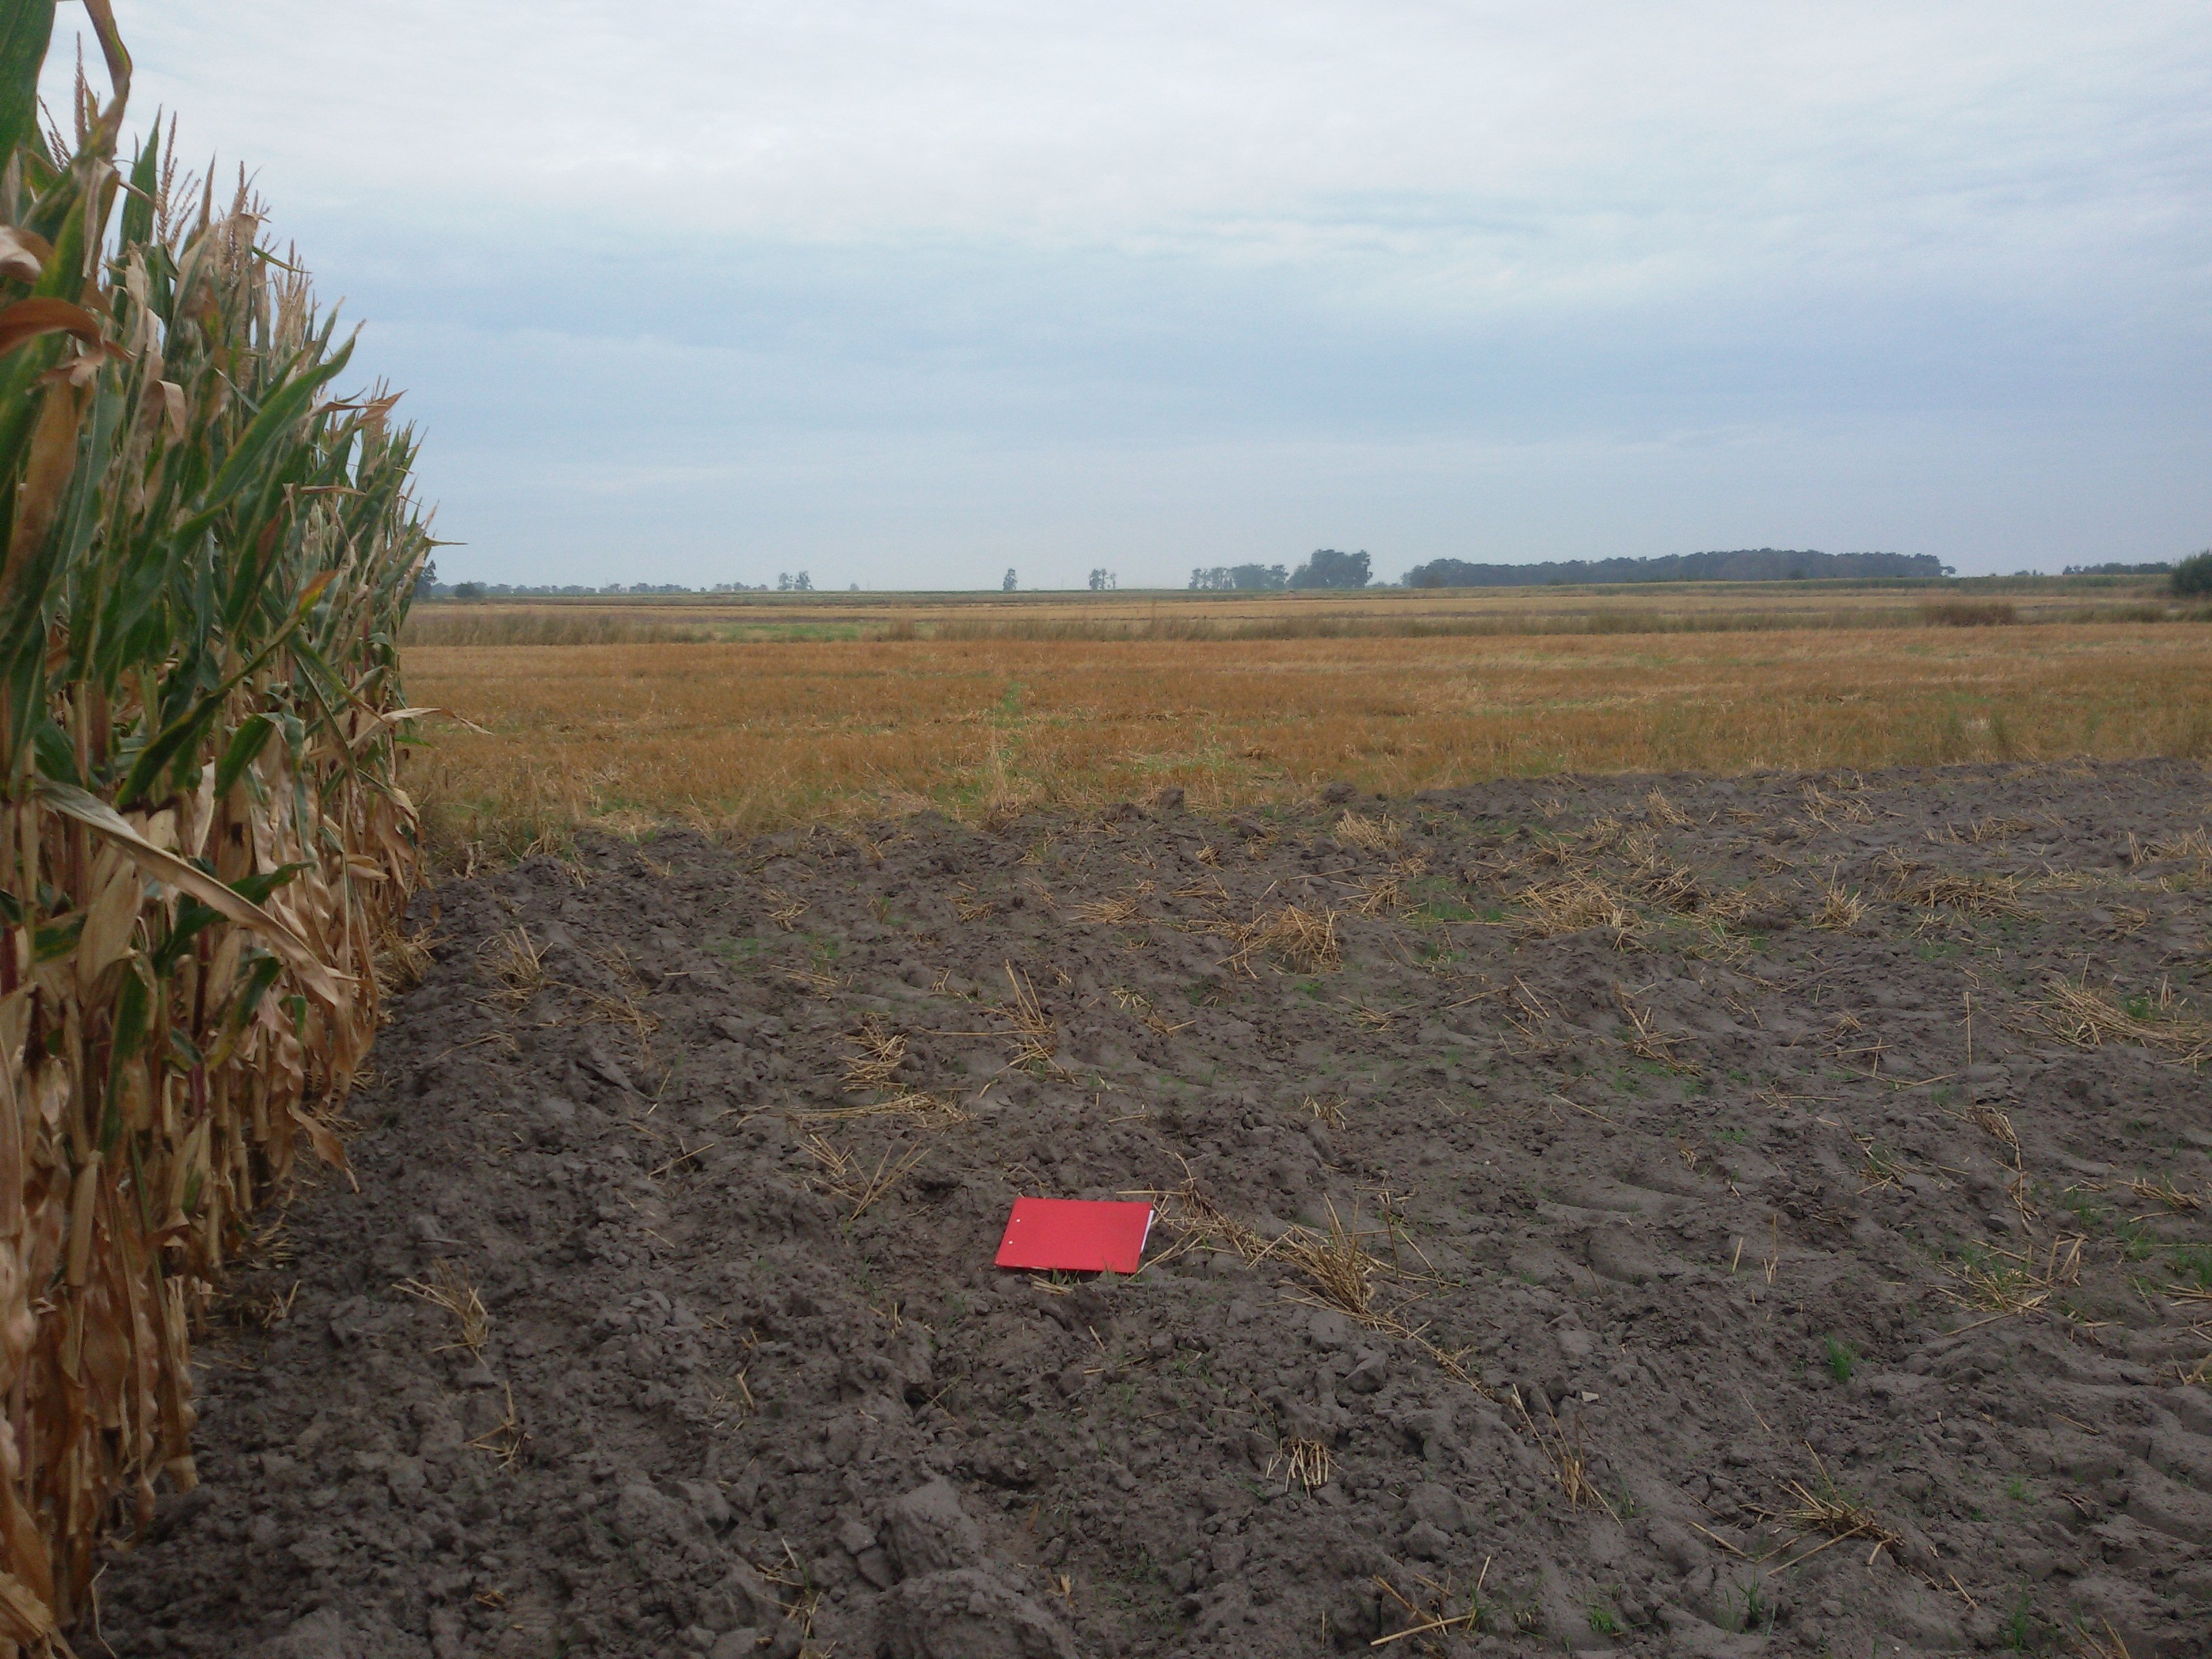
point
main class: Cropland
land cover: Rye
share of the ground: < 10 %
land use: Agriculture (excluding fallow land and kitchen gardens)
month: August
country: PL
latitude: 51.8075
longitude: 17.8905
